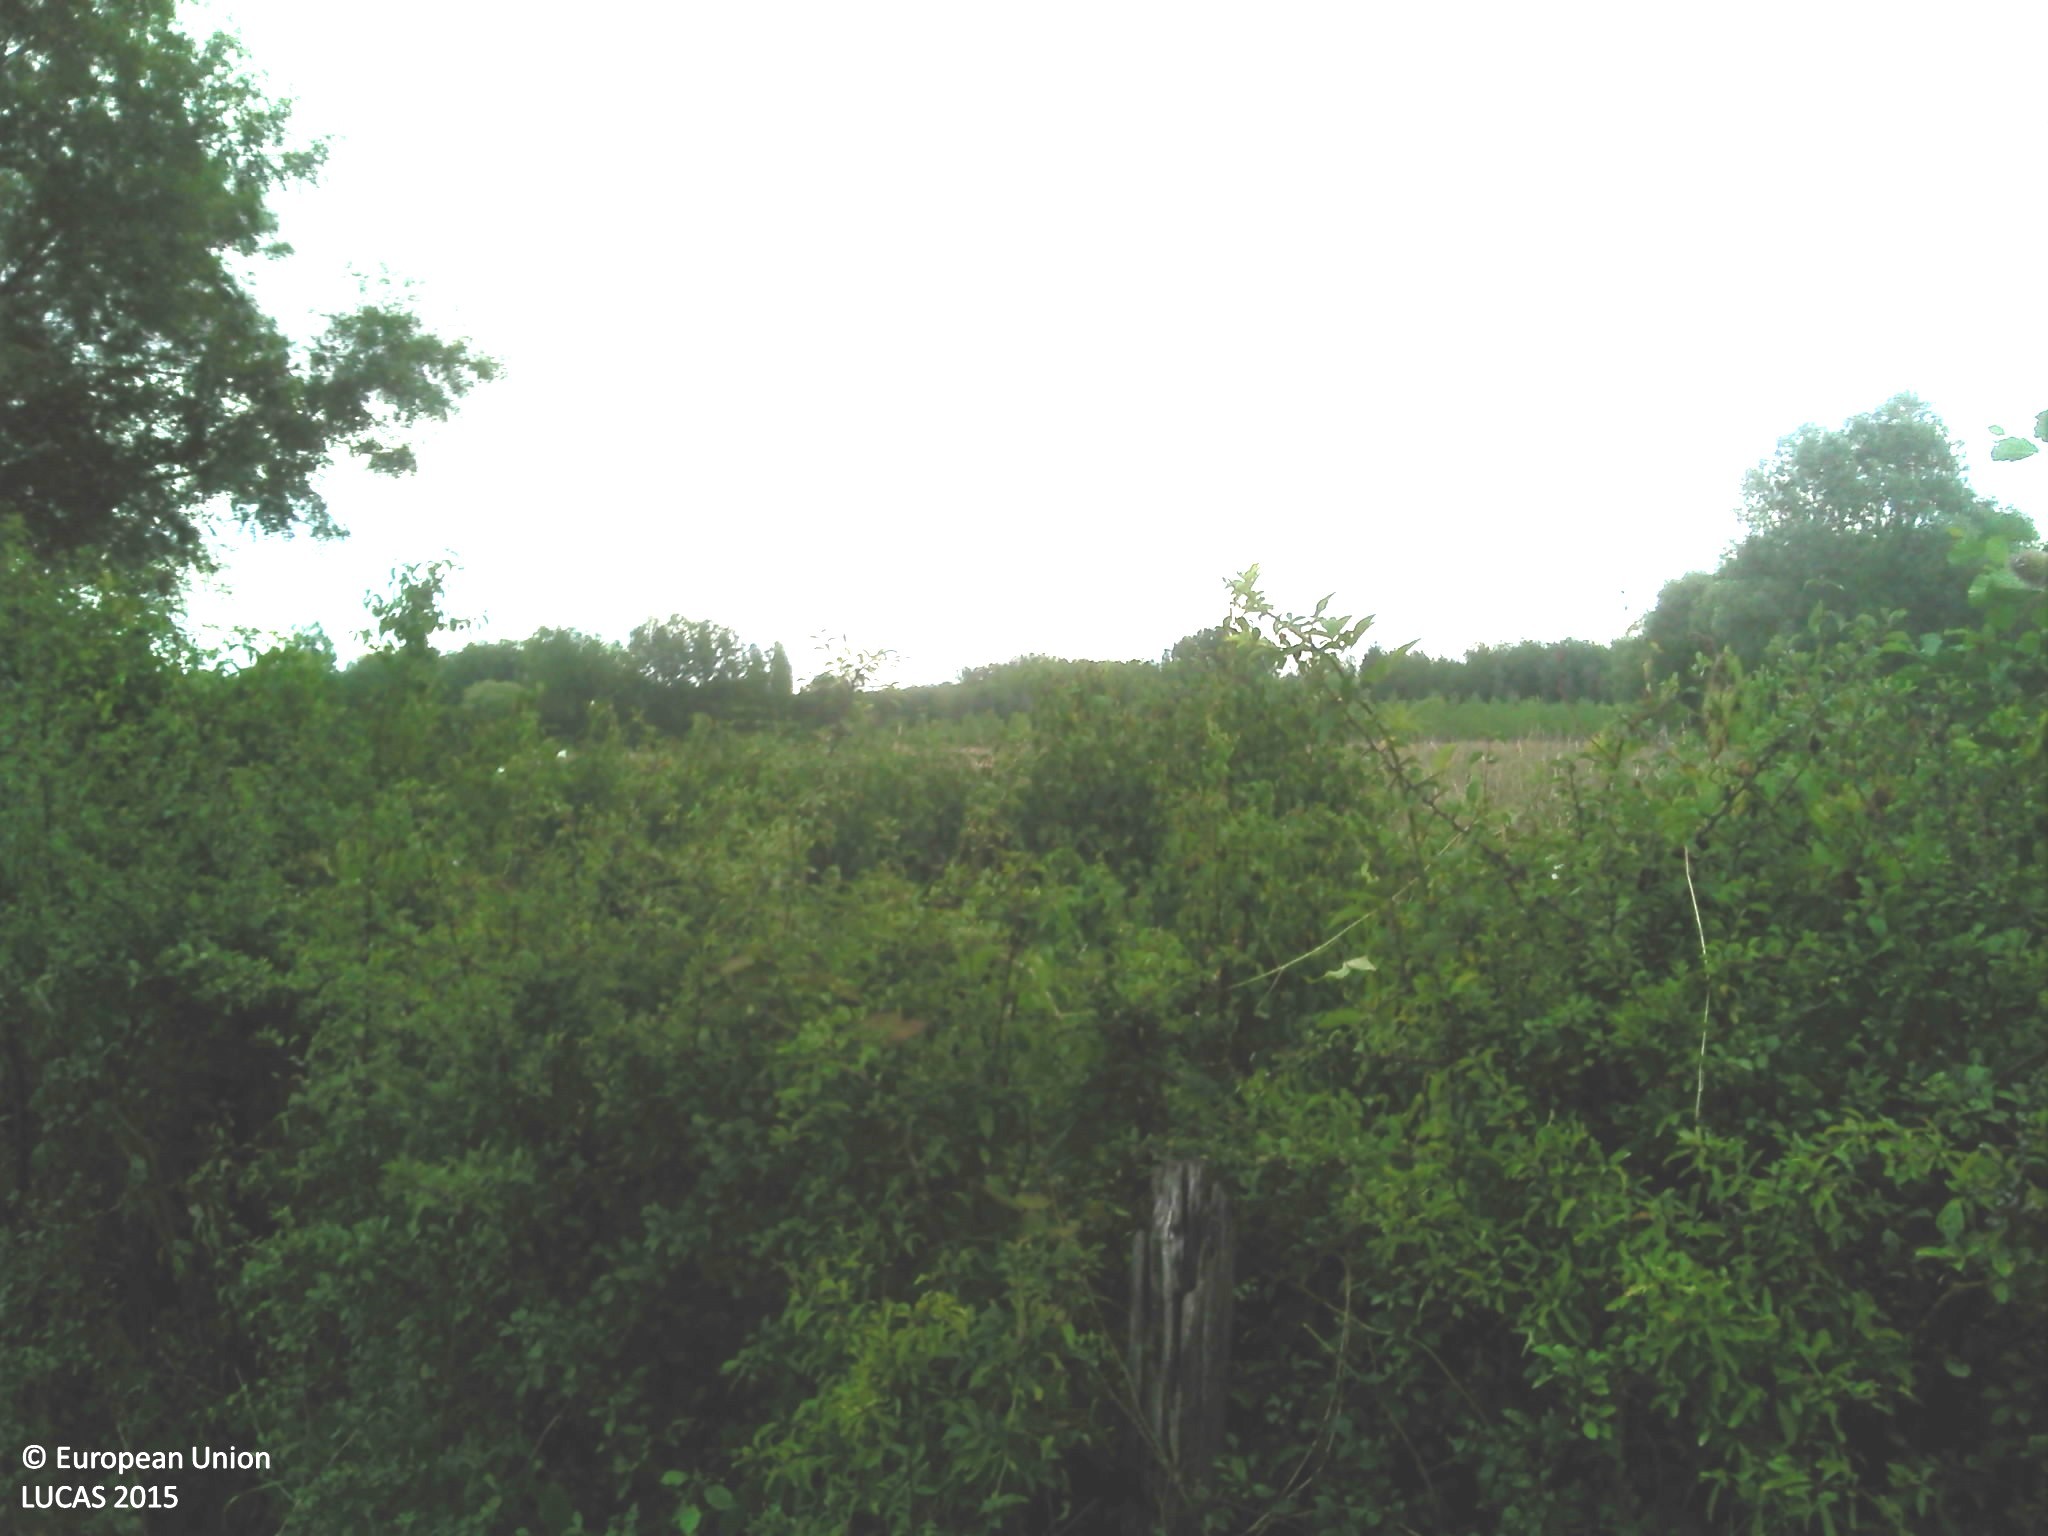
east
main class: Grassland
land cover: Grassland without tree/shrub cover
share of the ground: > 75 %
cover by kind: herbaceous plants 100 %
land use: Agriculture (excluding fallow land and kitchen gardens)
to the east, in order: Grassland without tree/shrub cover; Electric lines; Fences; Managed hedges; Ditches and canals; Spontaneously vegetated surfaces
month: July
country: FR
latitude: 46.7353
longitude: 4.9107
